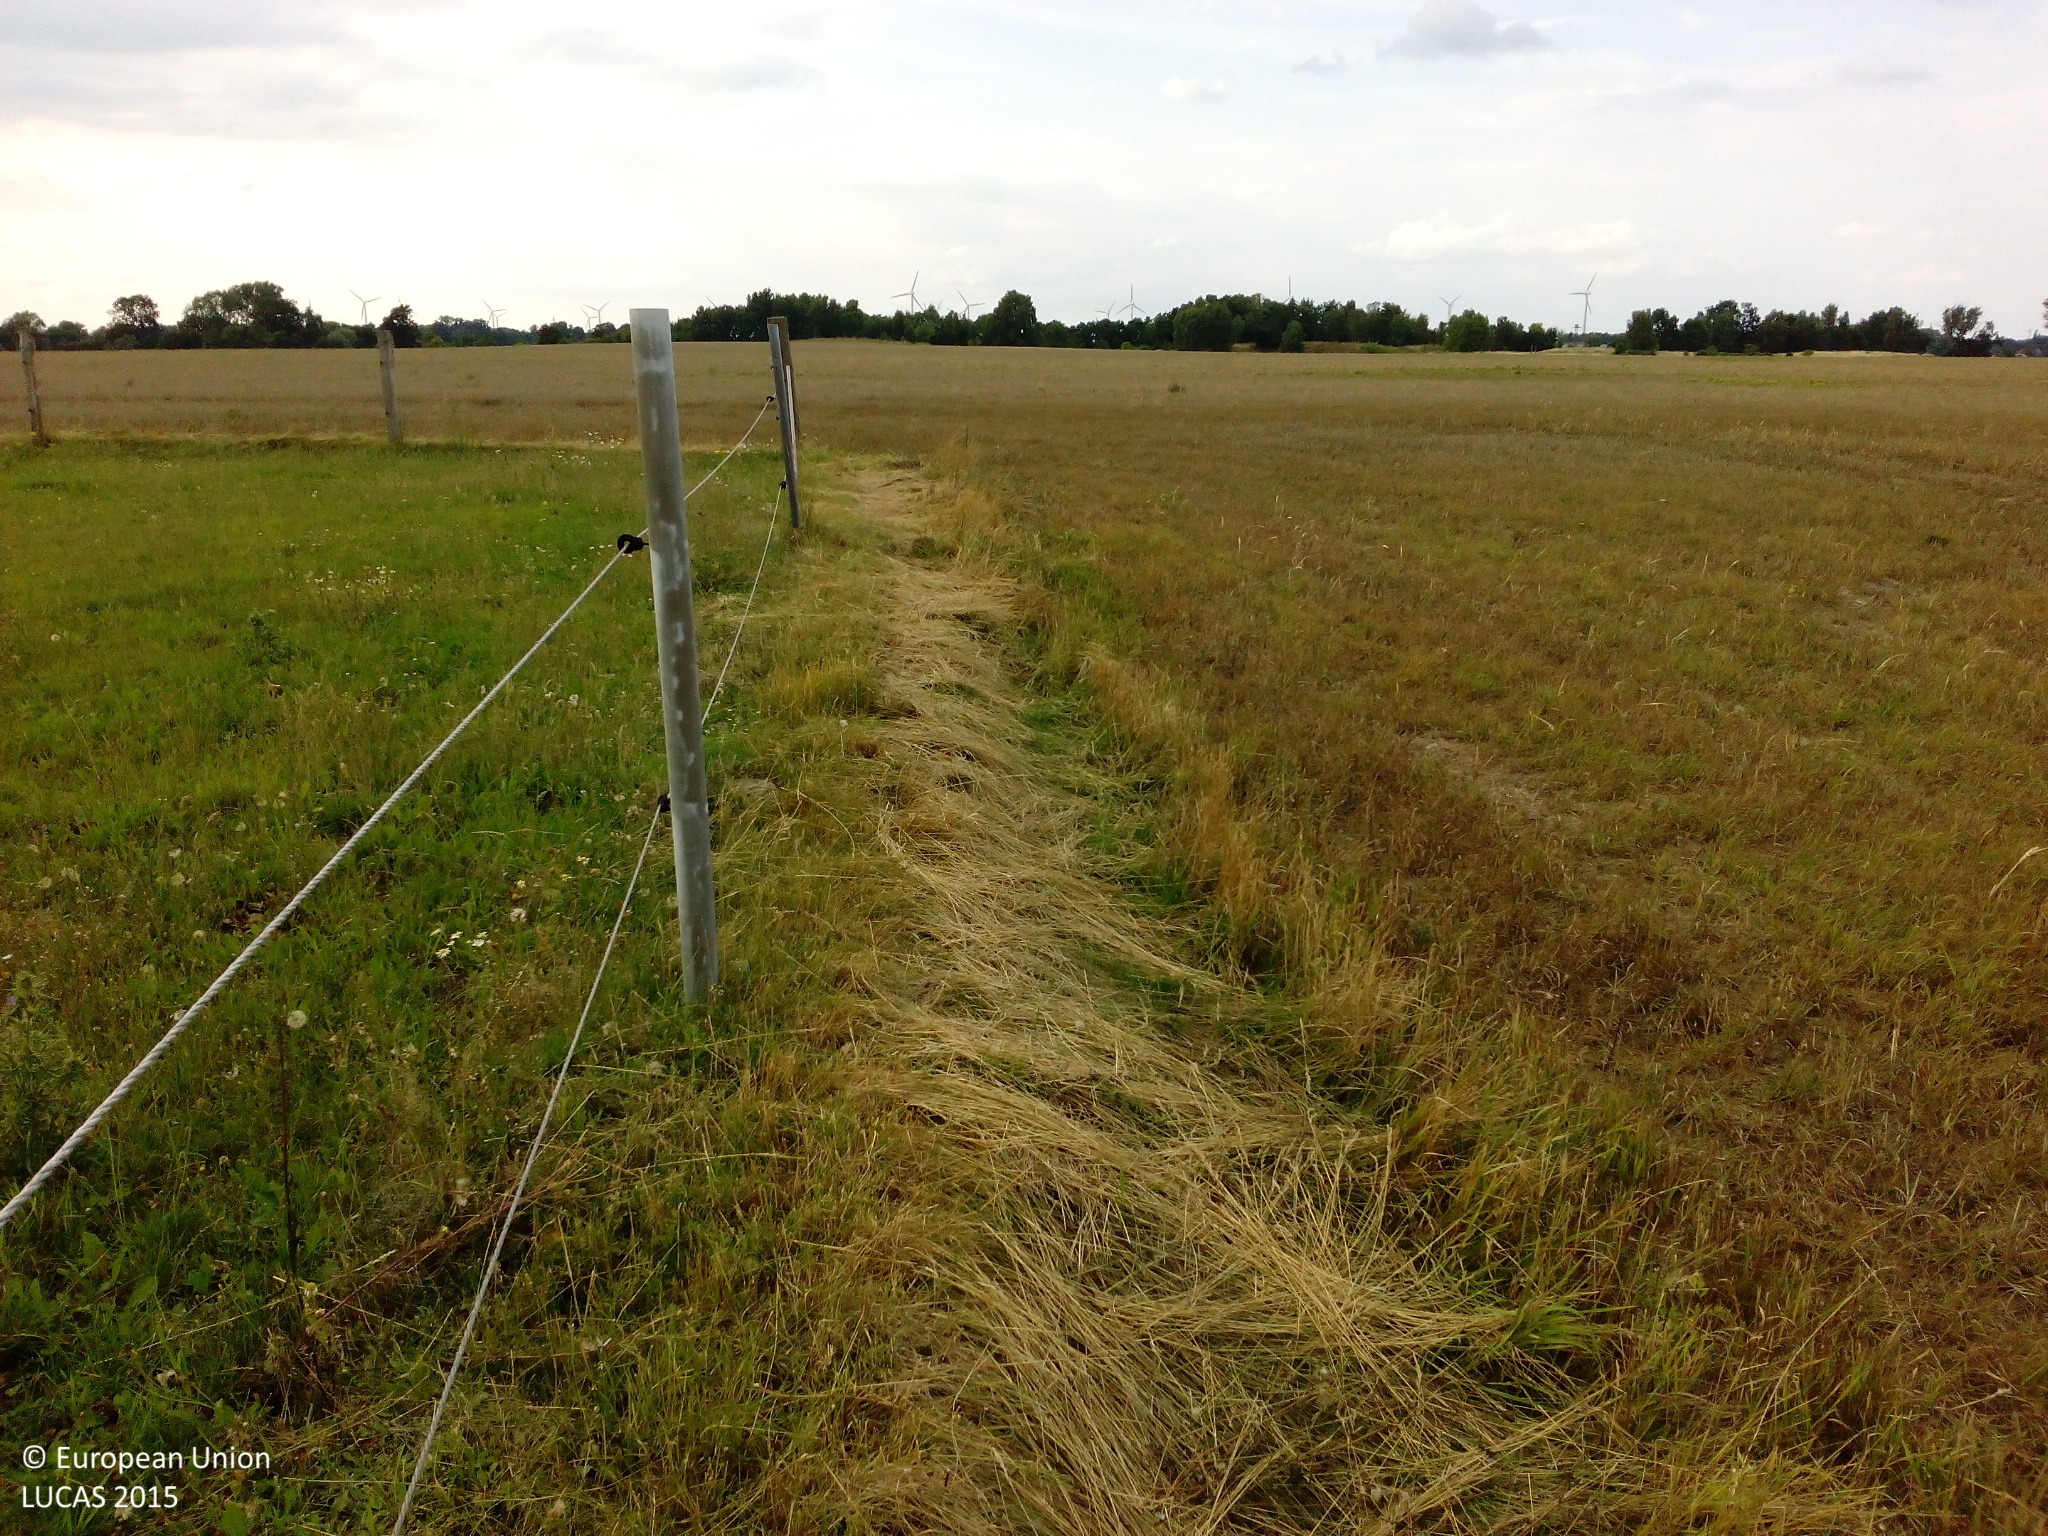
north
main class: Grassland
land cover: Grassland without tree/shrub cover
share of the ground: > 75 %
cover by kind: herbaceous plants 100 %
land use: Agriculture (excluding fallow land and kitchen gardens)
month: July
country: DE
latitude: 52.9479
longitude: 12.3360
